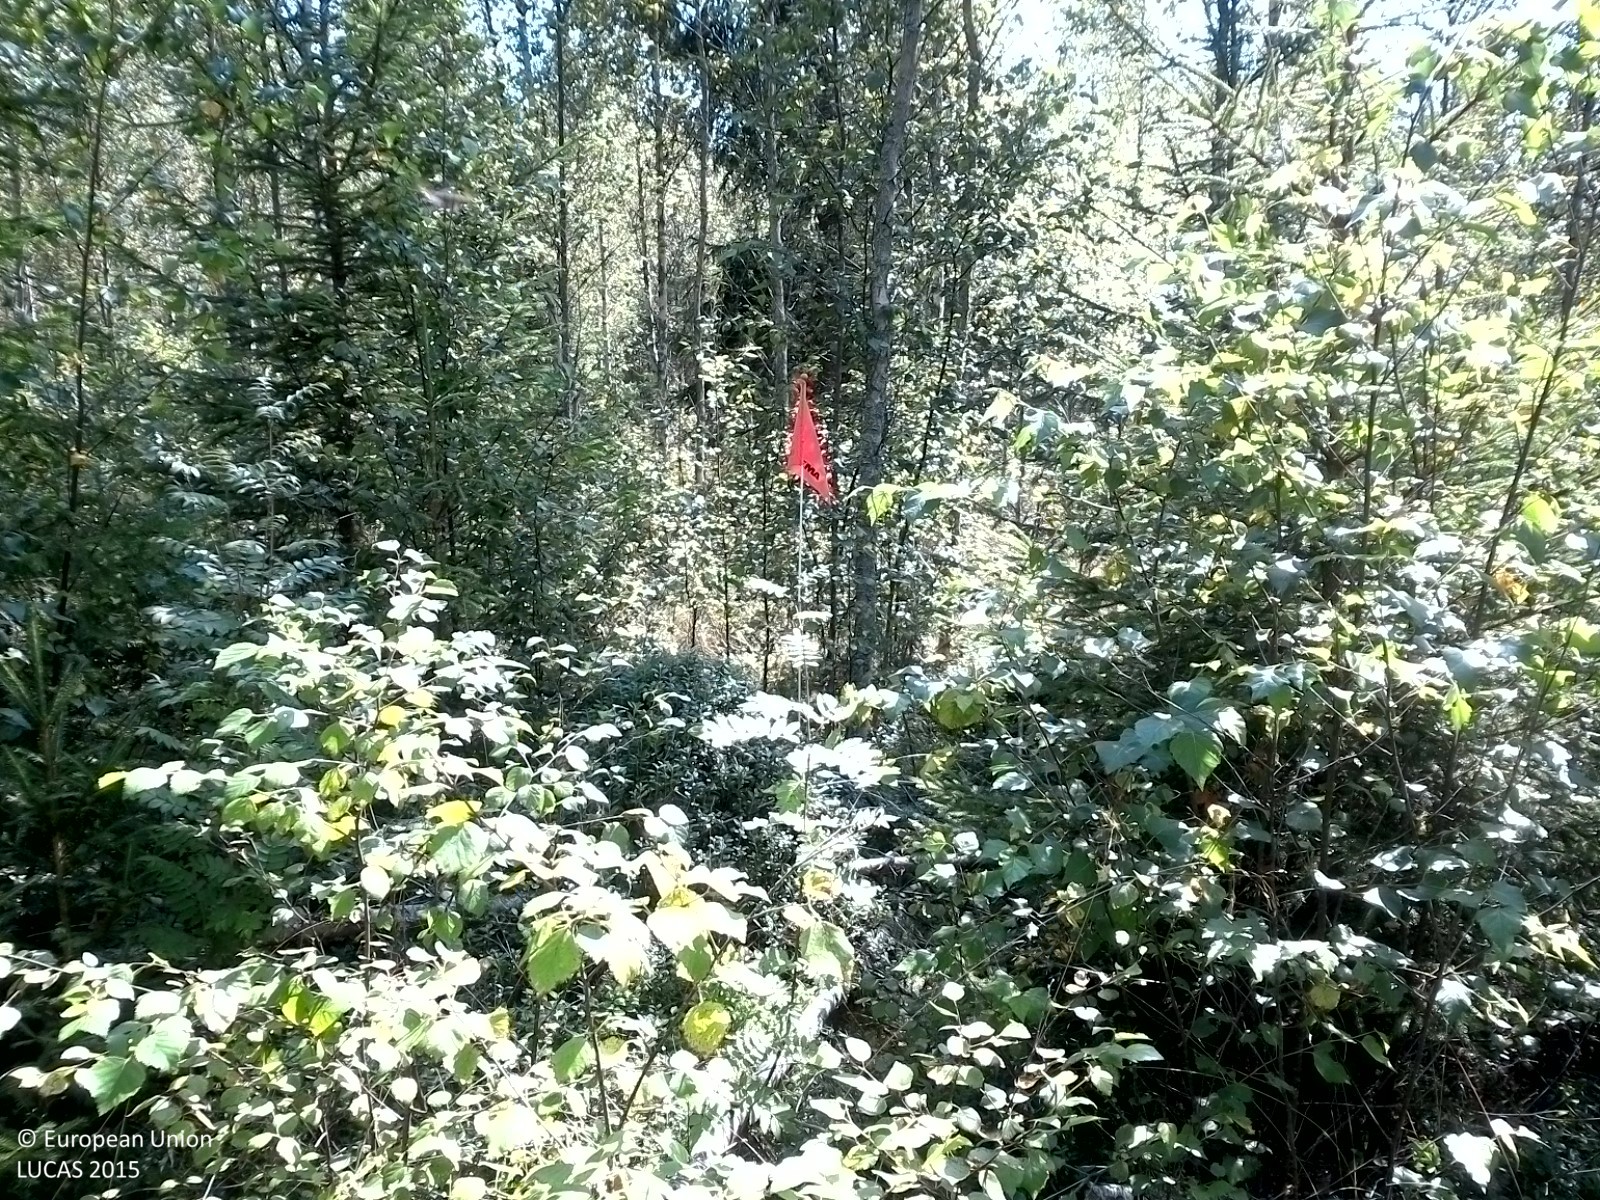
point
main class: Woodland
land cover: Spruce dominated mixed woodland
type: boreal forest
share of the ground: > 75 %
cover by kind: coniferous forest trees 45 %, broadleaved forest trees 35 %, herbaceous plants 20 %
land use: Forestry
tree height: < 5 m
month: August
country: SE
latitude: 59.0895
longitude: 14.7915
